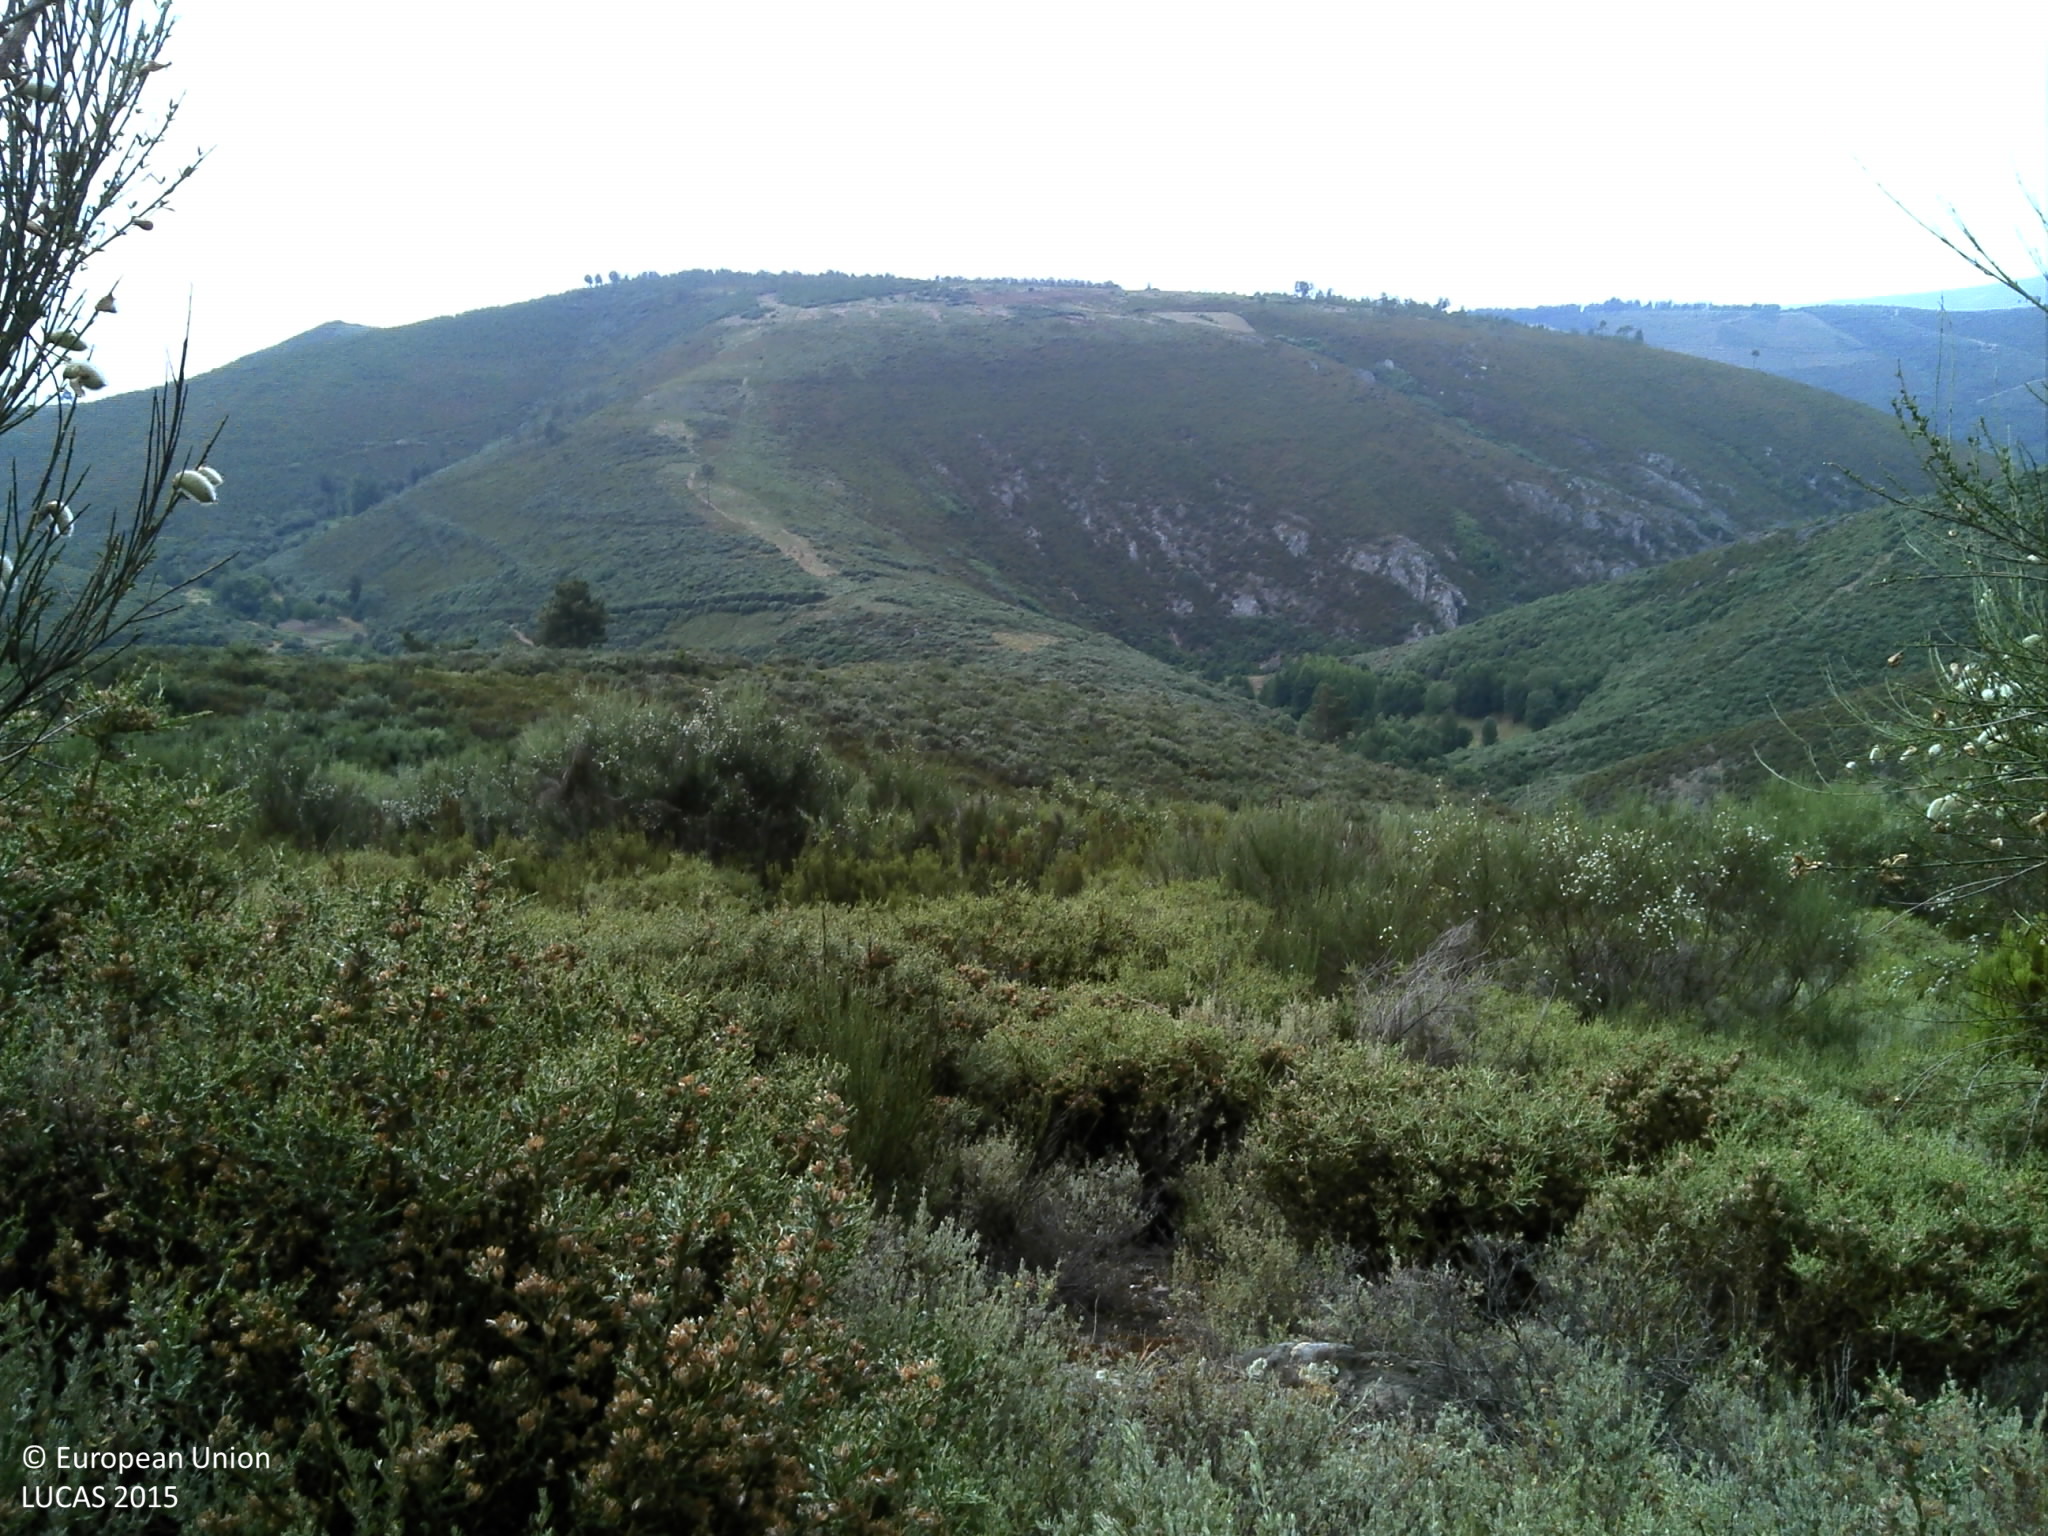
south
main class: Shrubland
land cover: Shrubland without tree cover
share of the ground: > 75 %
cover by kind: shrubs 90 %, unconsolidated bare surface 10 %
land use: Semi-natural and natural areas not in use
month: June
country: PT
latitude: 41.4751
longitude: -7.4533
